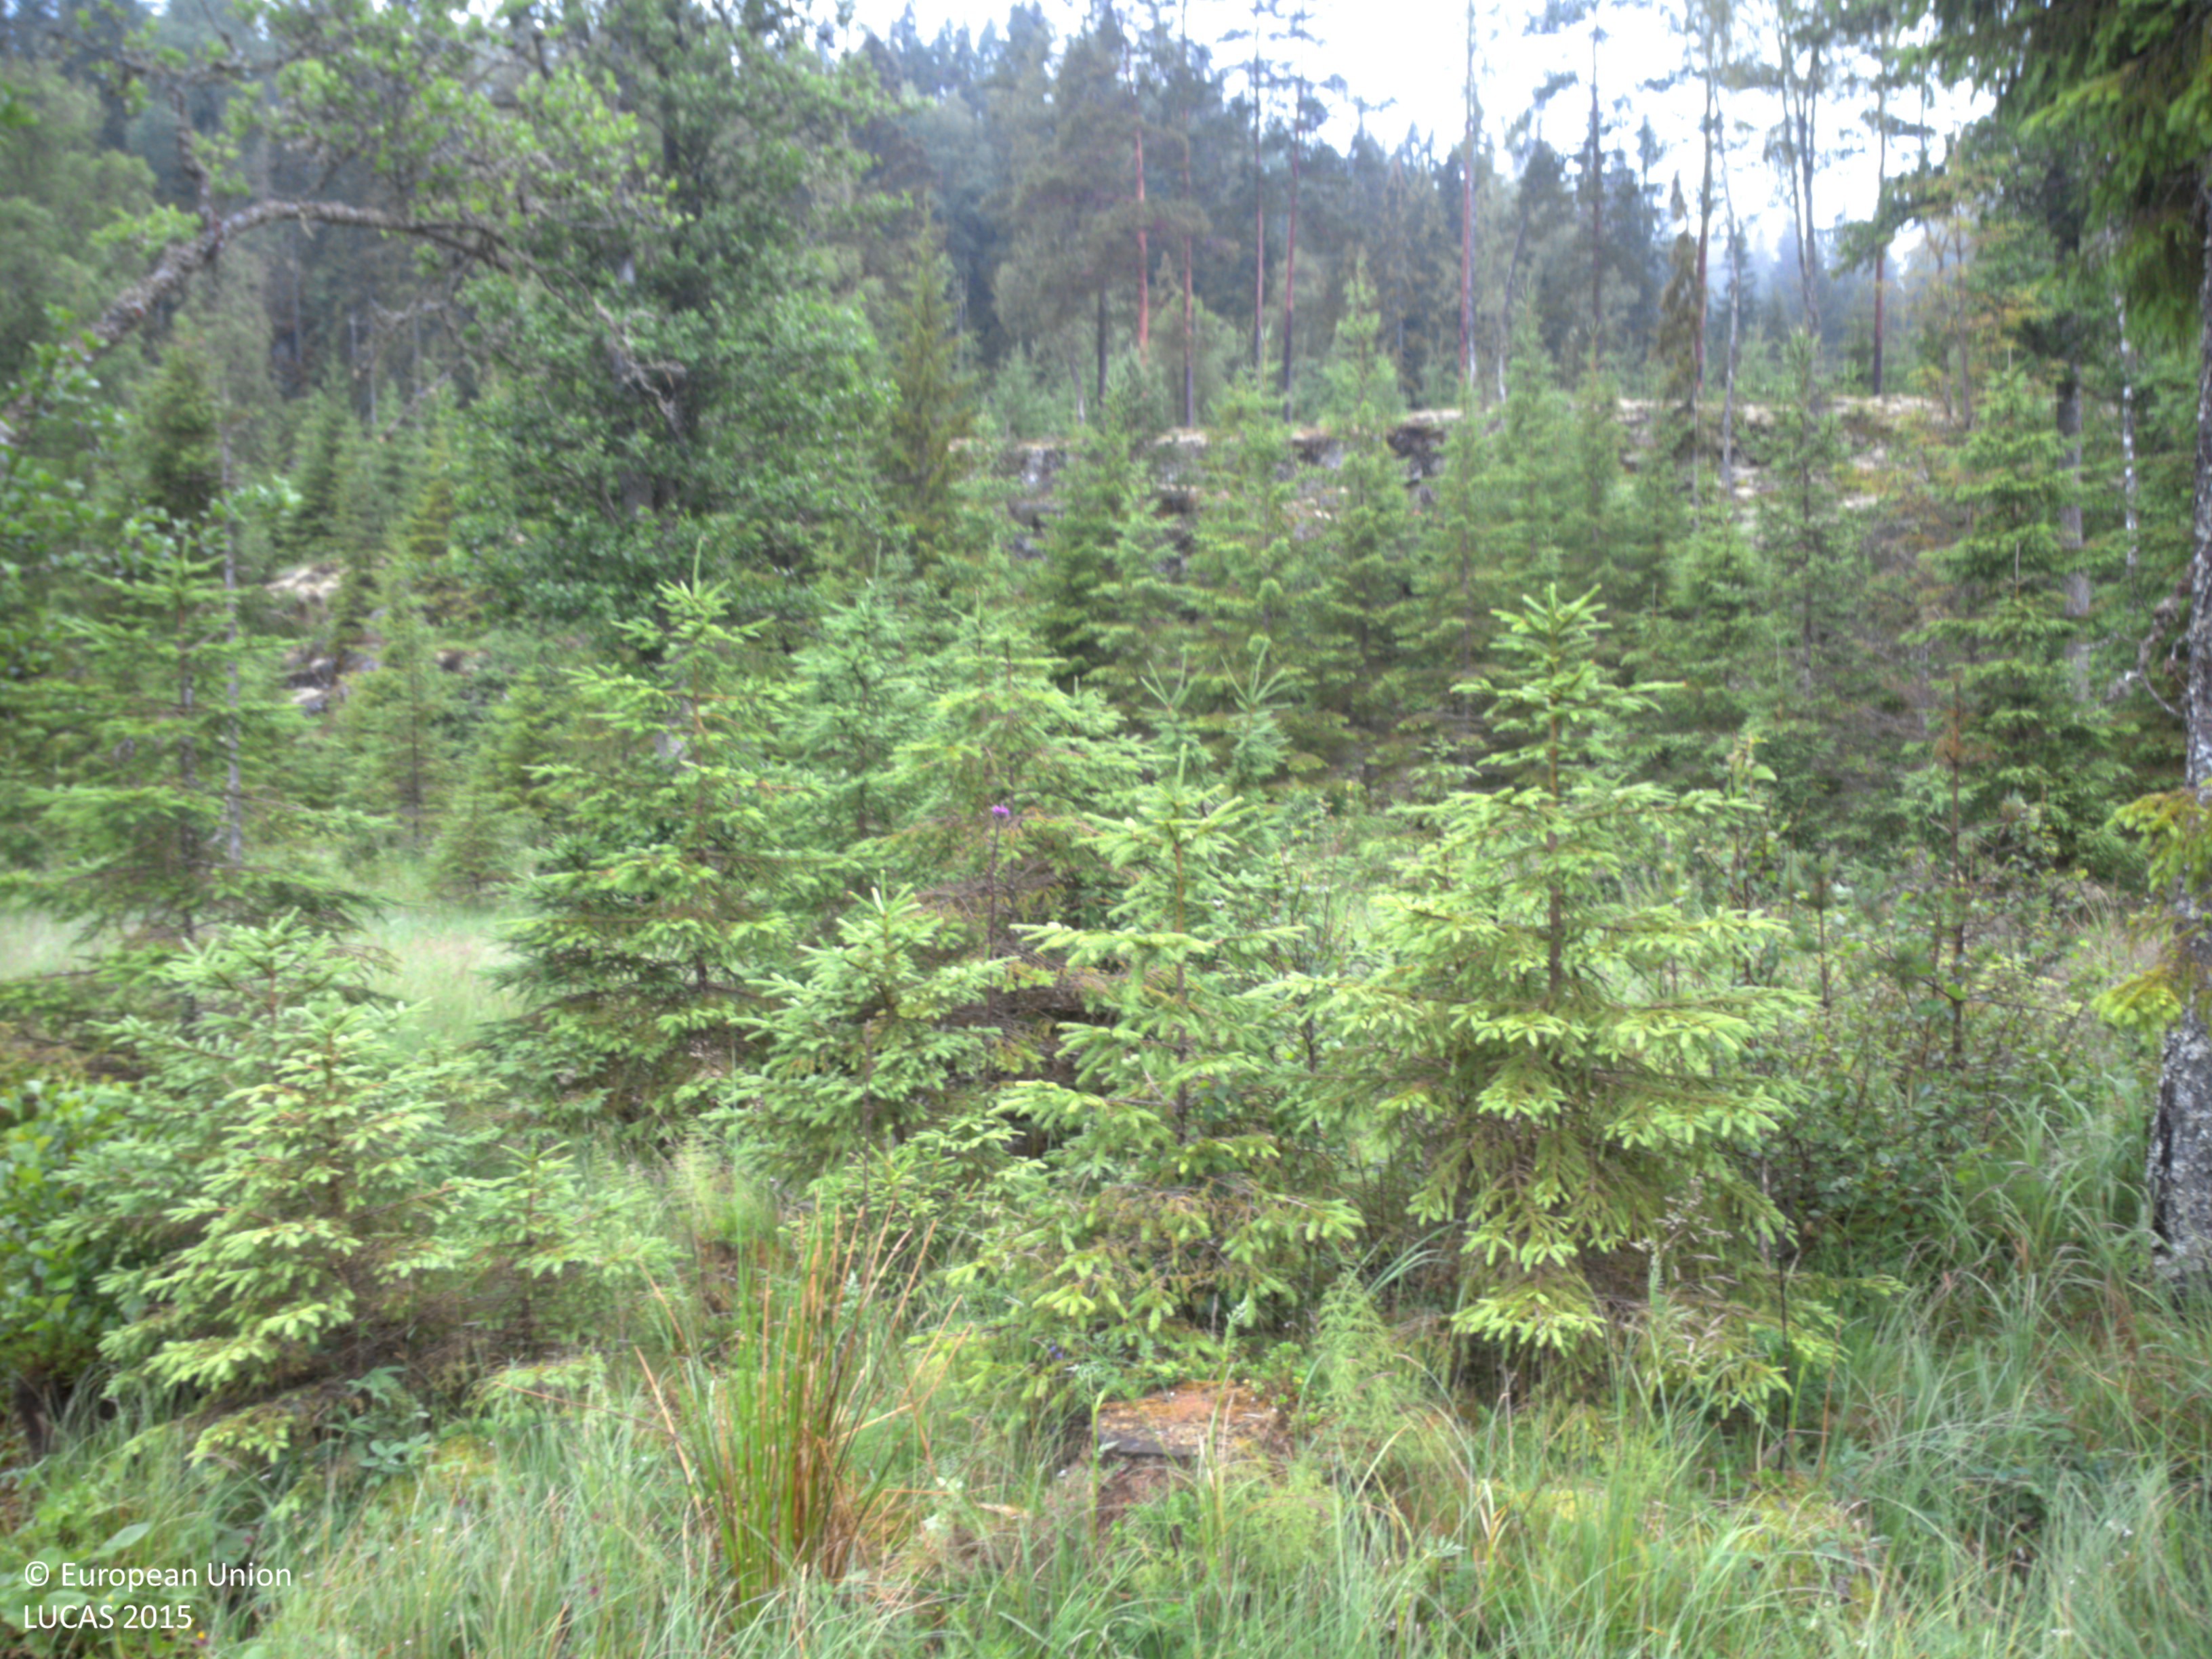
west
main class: Grassland
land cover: Grassland with sparse tree/shrub cover
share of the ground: > 75 %
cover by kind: herbaceous plants 95 %, coniferous forest trees 5 %
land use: Semi-natural and natural areas not in use
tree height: < 5 m
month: July
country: SE
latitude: 58.9060
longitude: 12.0265
